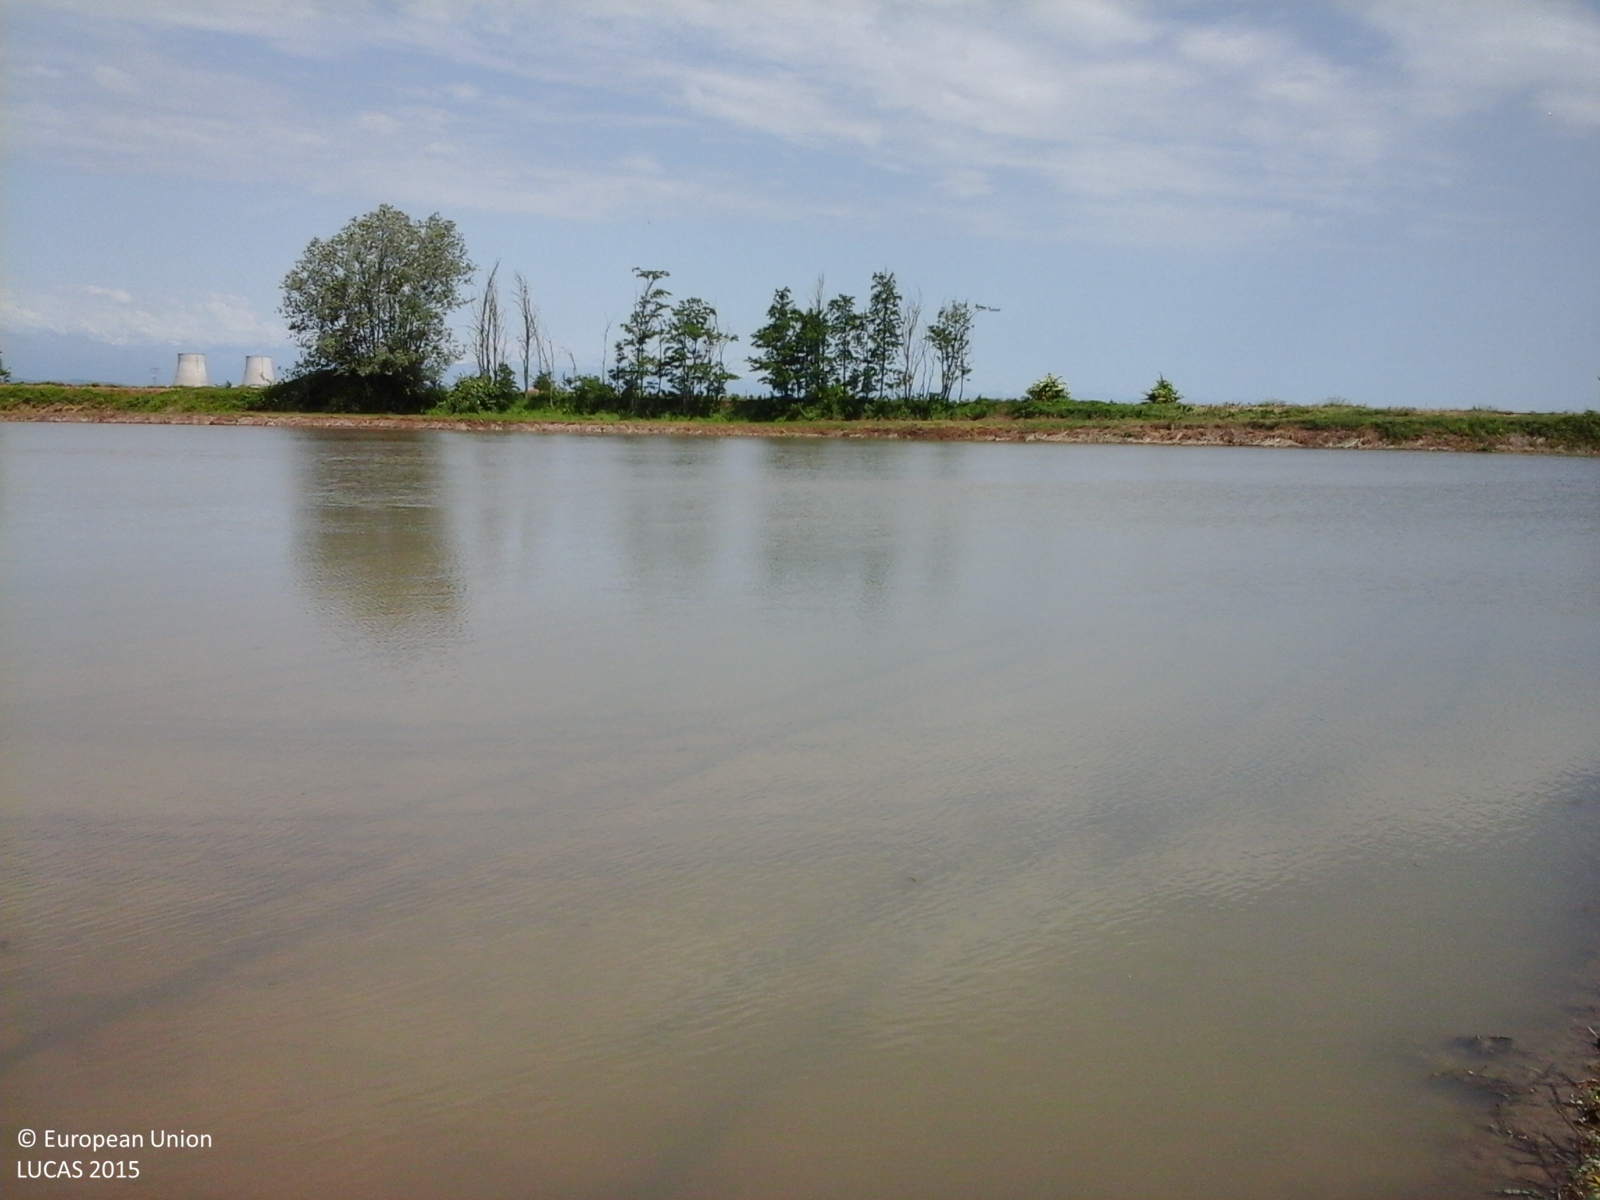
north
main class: Cropland
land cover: Rice
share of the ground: 10 - 25 %
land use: Agriculture (excluding fallow land and kitchen gardens)
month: May
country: IT
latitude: 45.2188
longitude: 8.2076
